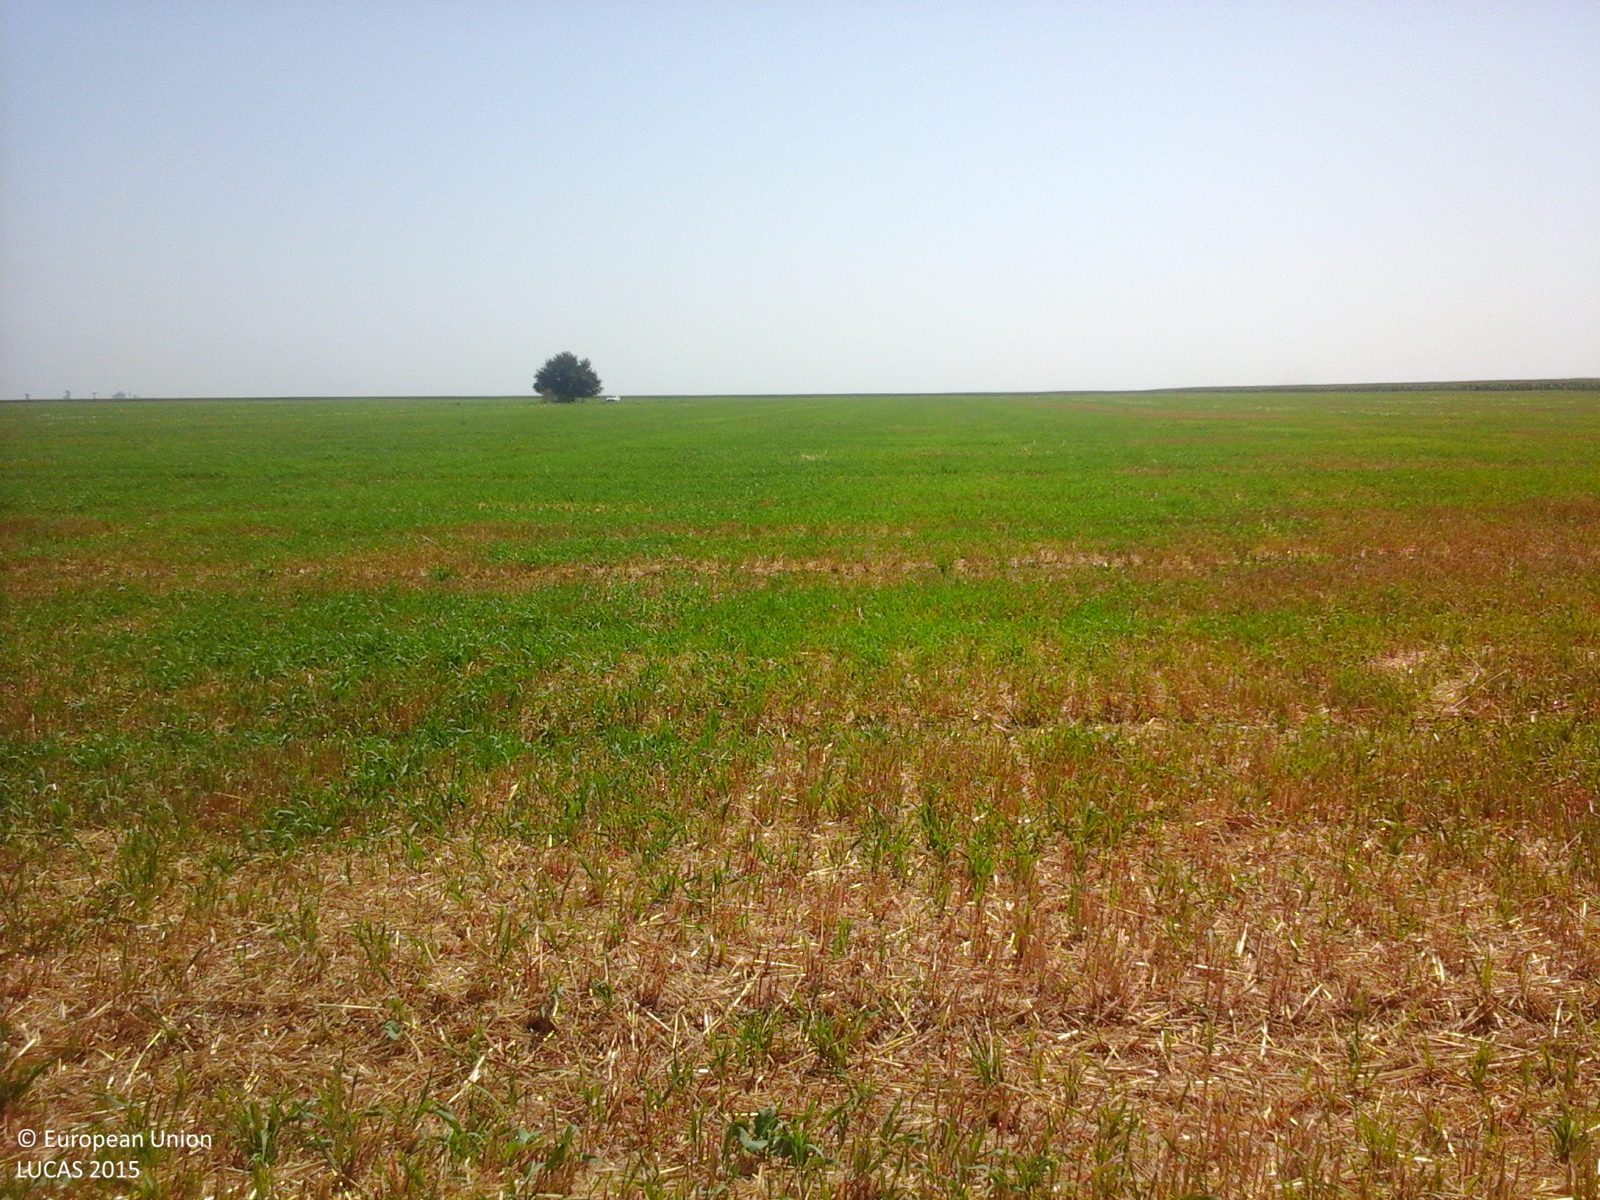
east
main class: Cropland
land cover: Durum wheat
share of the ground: > 75 %
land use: Agriculture (excluding fallow land and kitchen gardens)
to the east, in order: Durum wheat
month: July
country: RO
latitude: 44.5074
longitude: 27.2813
